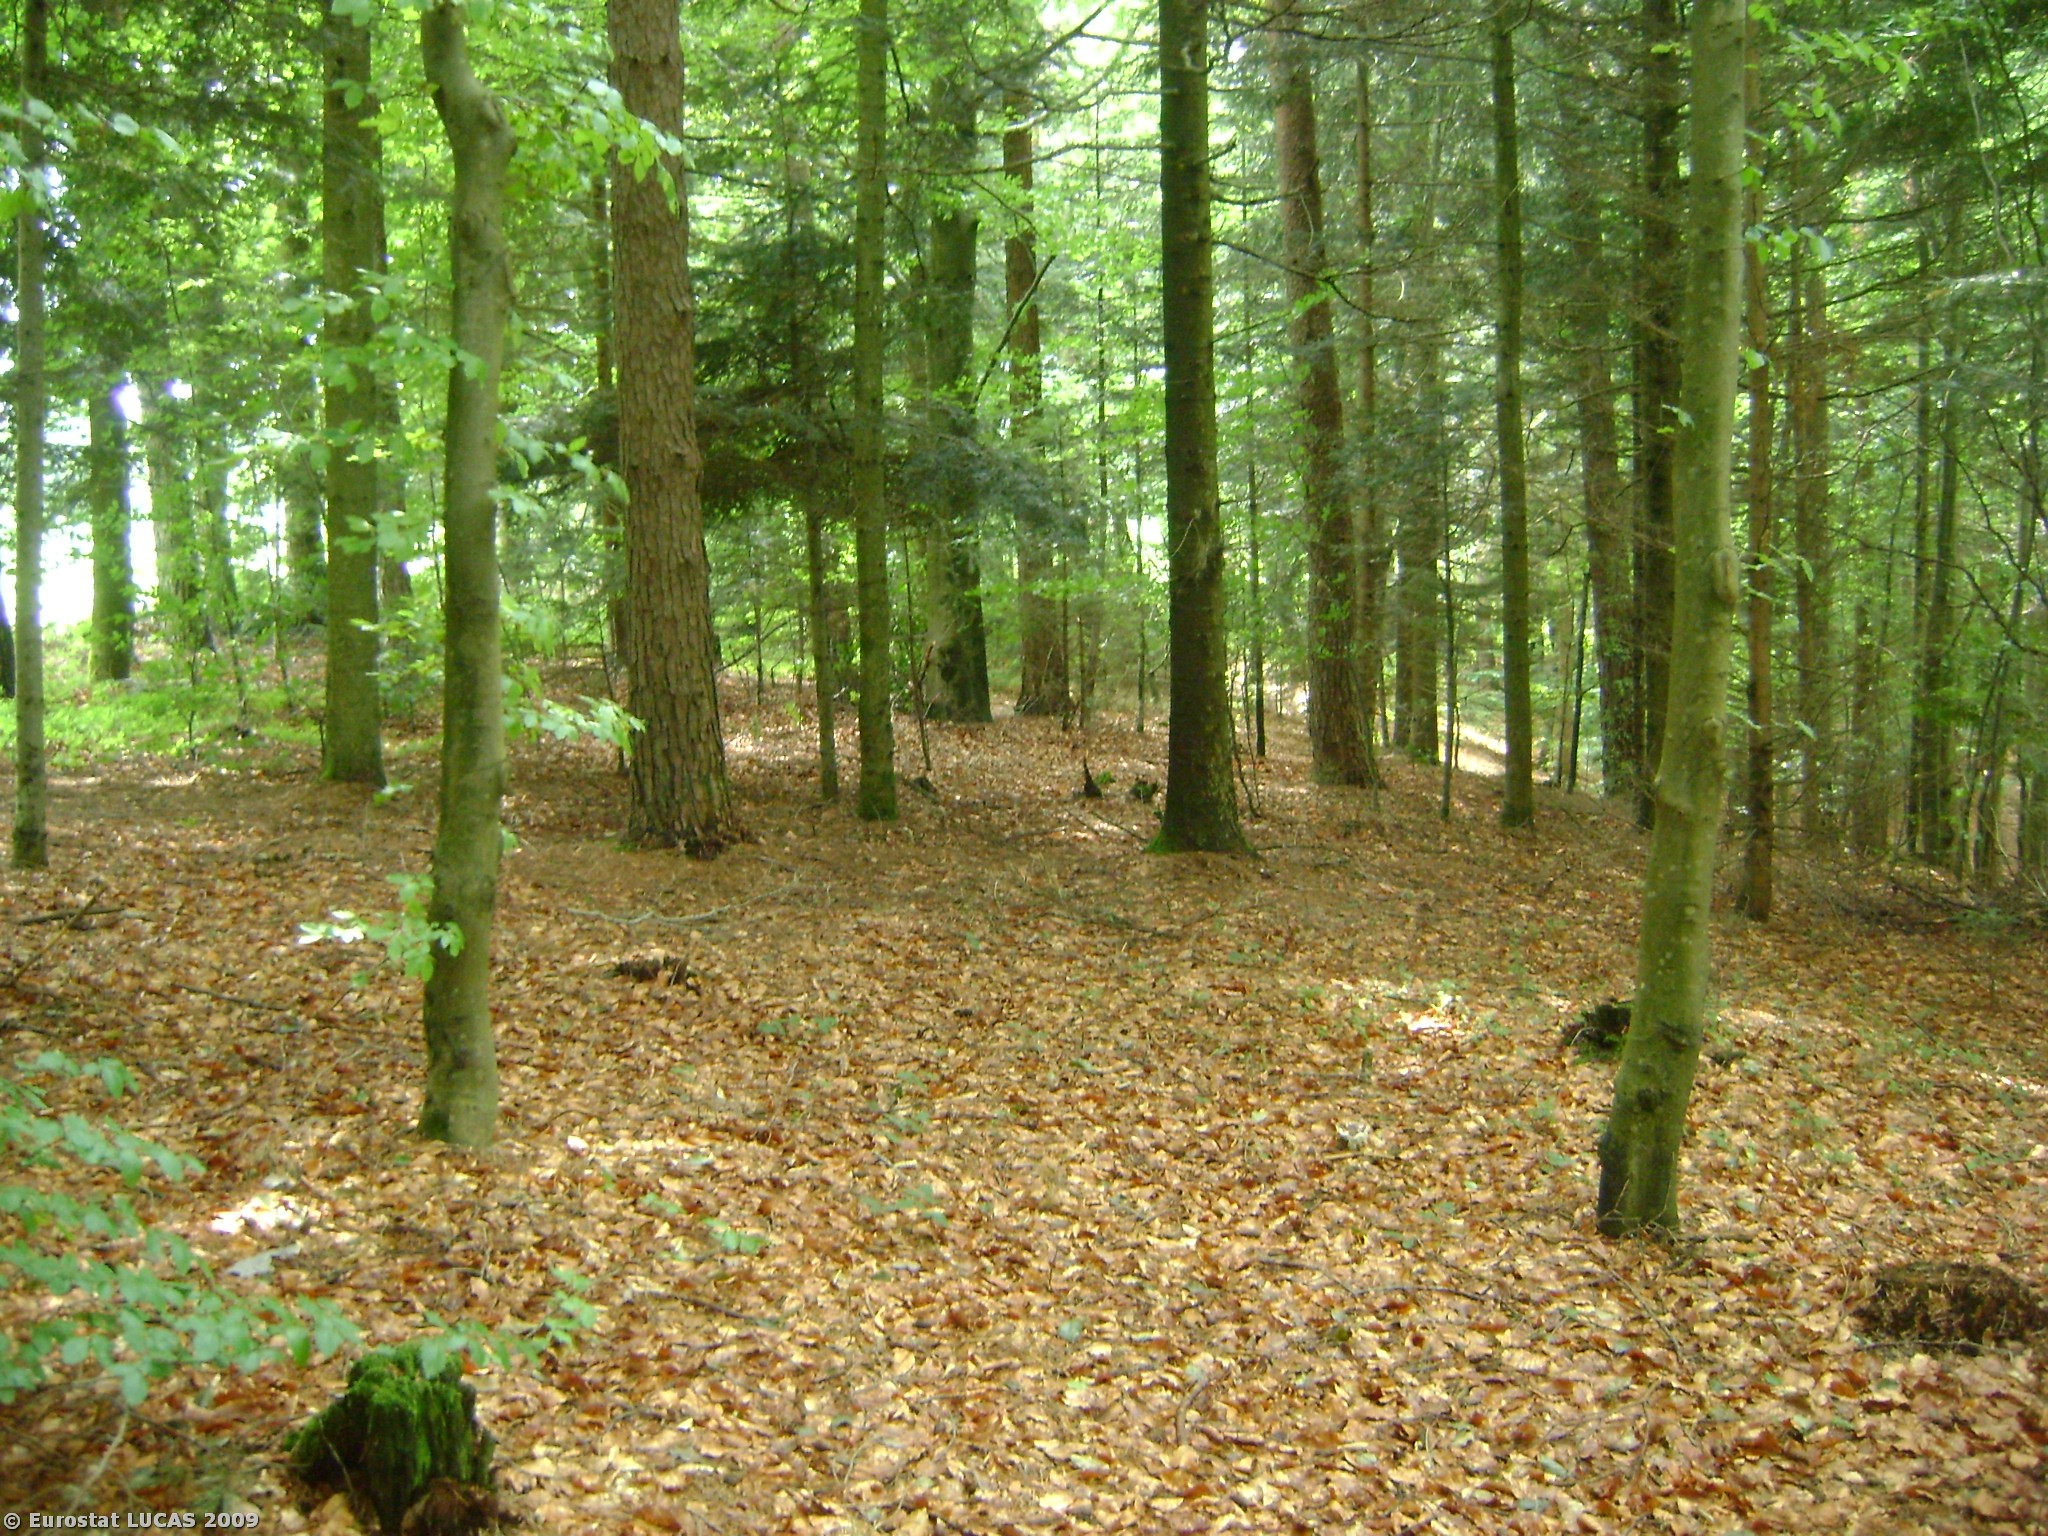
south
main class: Woodland
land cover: Mixed woodland
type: hemiboreal forest and nemoral coniferous forest and mixed broadleaved-coniferous forest
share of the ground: > 75 %
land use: Forestry
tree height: > 5 m
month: June
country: AT
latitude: 48.1392
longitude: 13.2647
